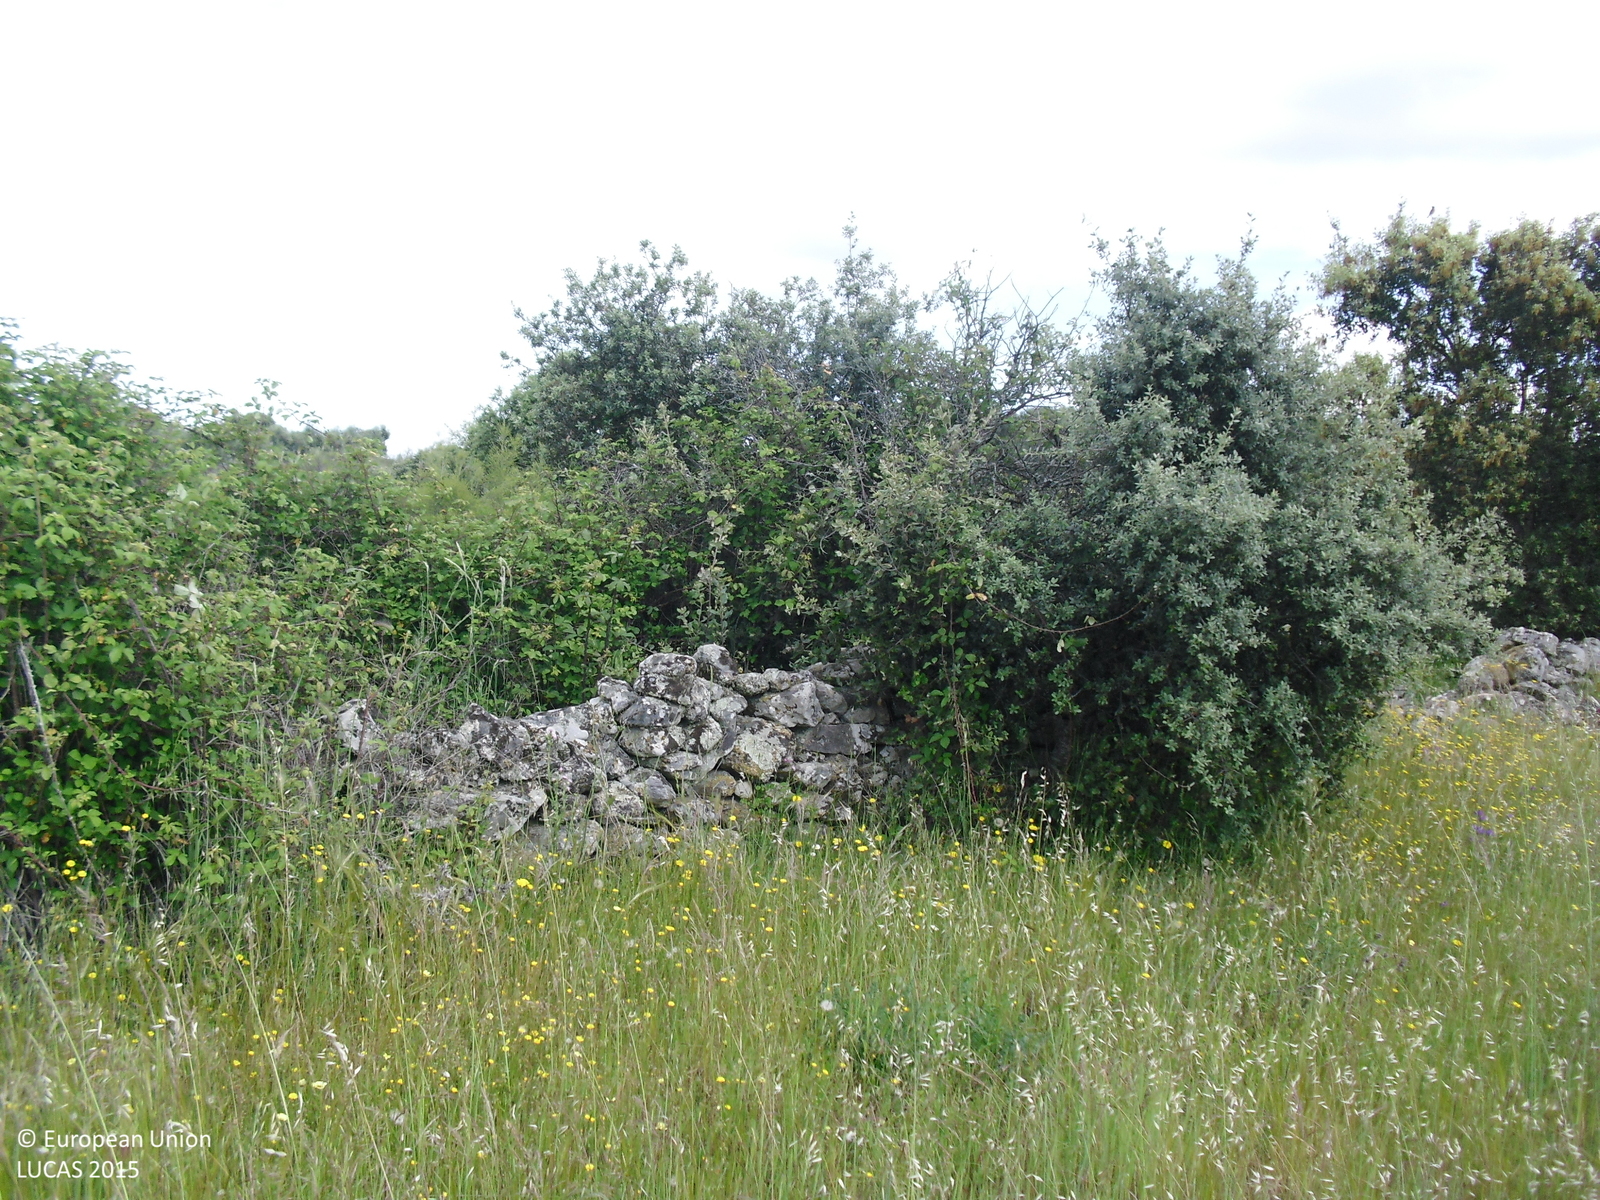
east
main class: Shrubland
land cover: Shrubland without tree cover
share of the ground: 10 - 25 %
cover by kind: herbaceous plants 90 %, shrubs 10 %
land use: Agriculture (excluding fallow land and kitchen gardens)
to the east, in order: Shrubland without tree cover; Spontaneously vegetated surfaces; Dry stone walls; Grassland without tree/shrub cover; Dry stone walls; Shruby margins; Grassland without tree/shrub cover; Dry stone walls; Tracks; Dry stone walls; Grassland with sparse tree/shrub cover; Dry stone walls; Olive groves; Dry stone walls; Grassland with sparse tree/shrub cover; Abandoned hedges; Dry stone walls; Grassland without tree/shrub cover; Dry stone walls; Single bushes/trees; Grassland without tree/shrub cover
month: April
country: ES
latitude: 39.3081
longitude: -6.0276
